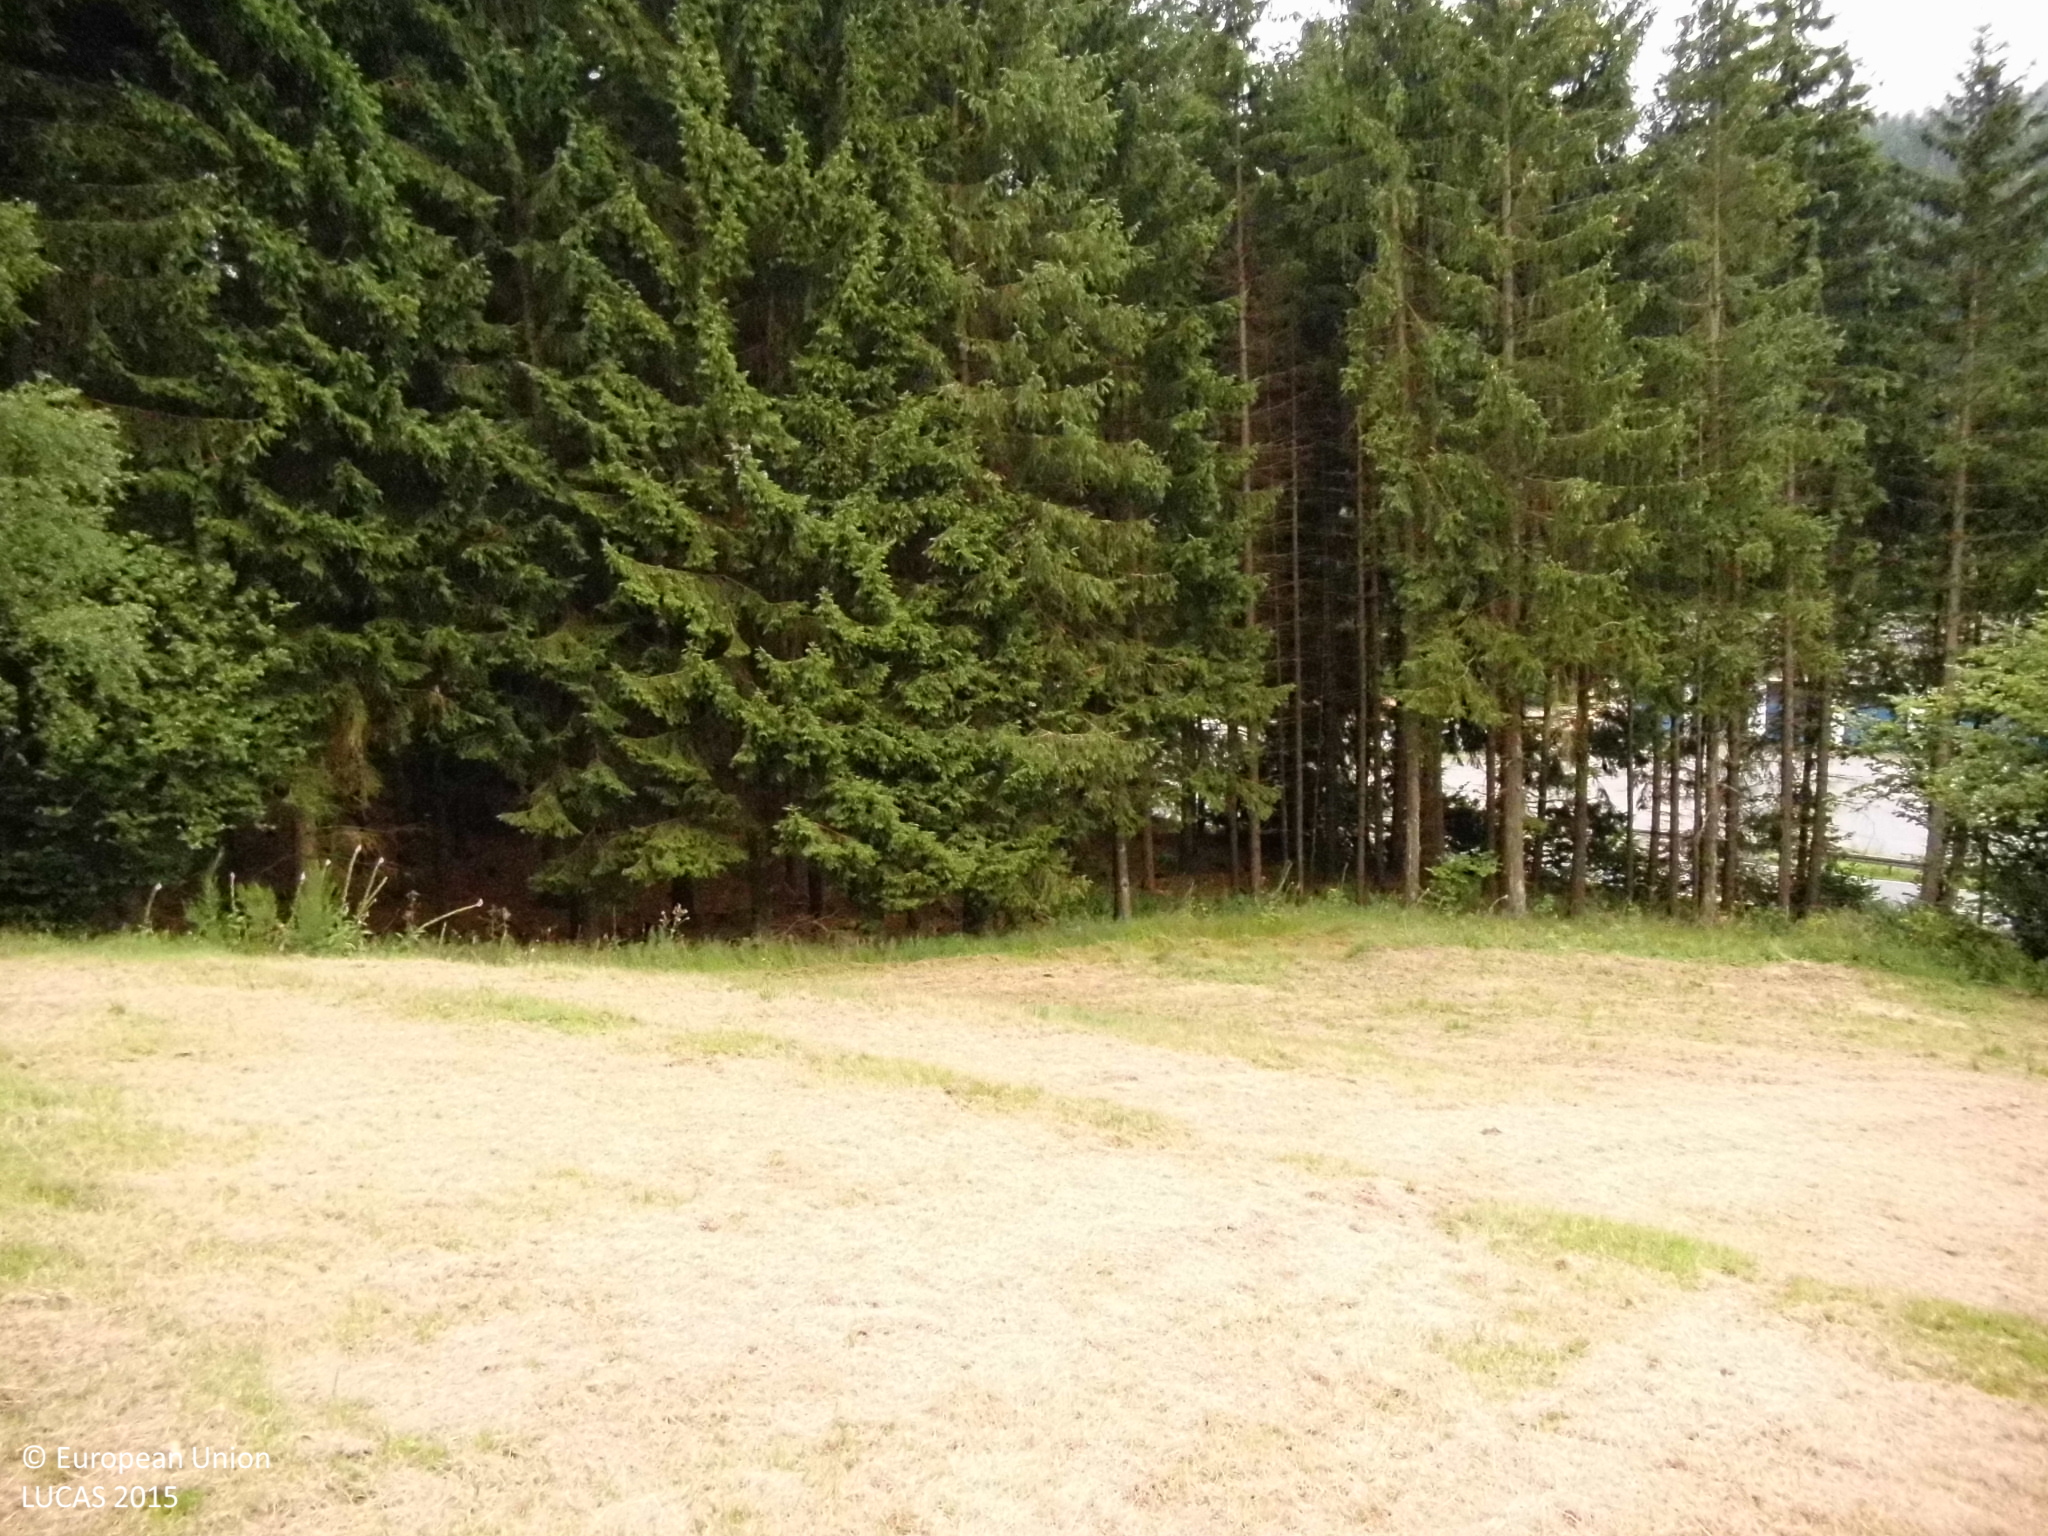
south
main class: Grassland
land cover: Grassland without tree/shrub cover
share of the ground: > 75 %
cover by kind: herbaceous plants 100 %
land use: Agriculture (excluding fallow land and kitchen gardens)
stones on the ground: 10 - 25 %
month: August
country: DE
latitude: 51.1465
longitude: 8.5852
